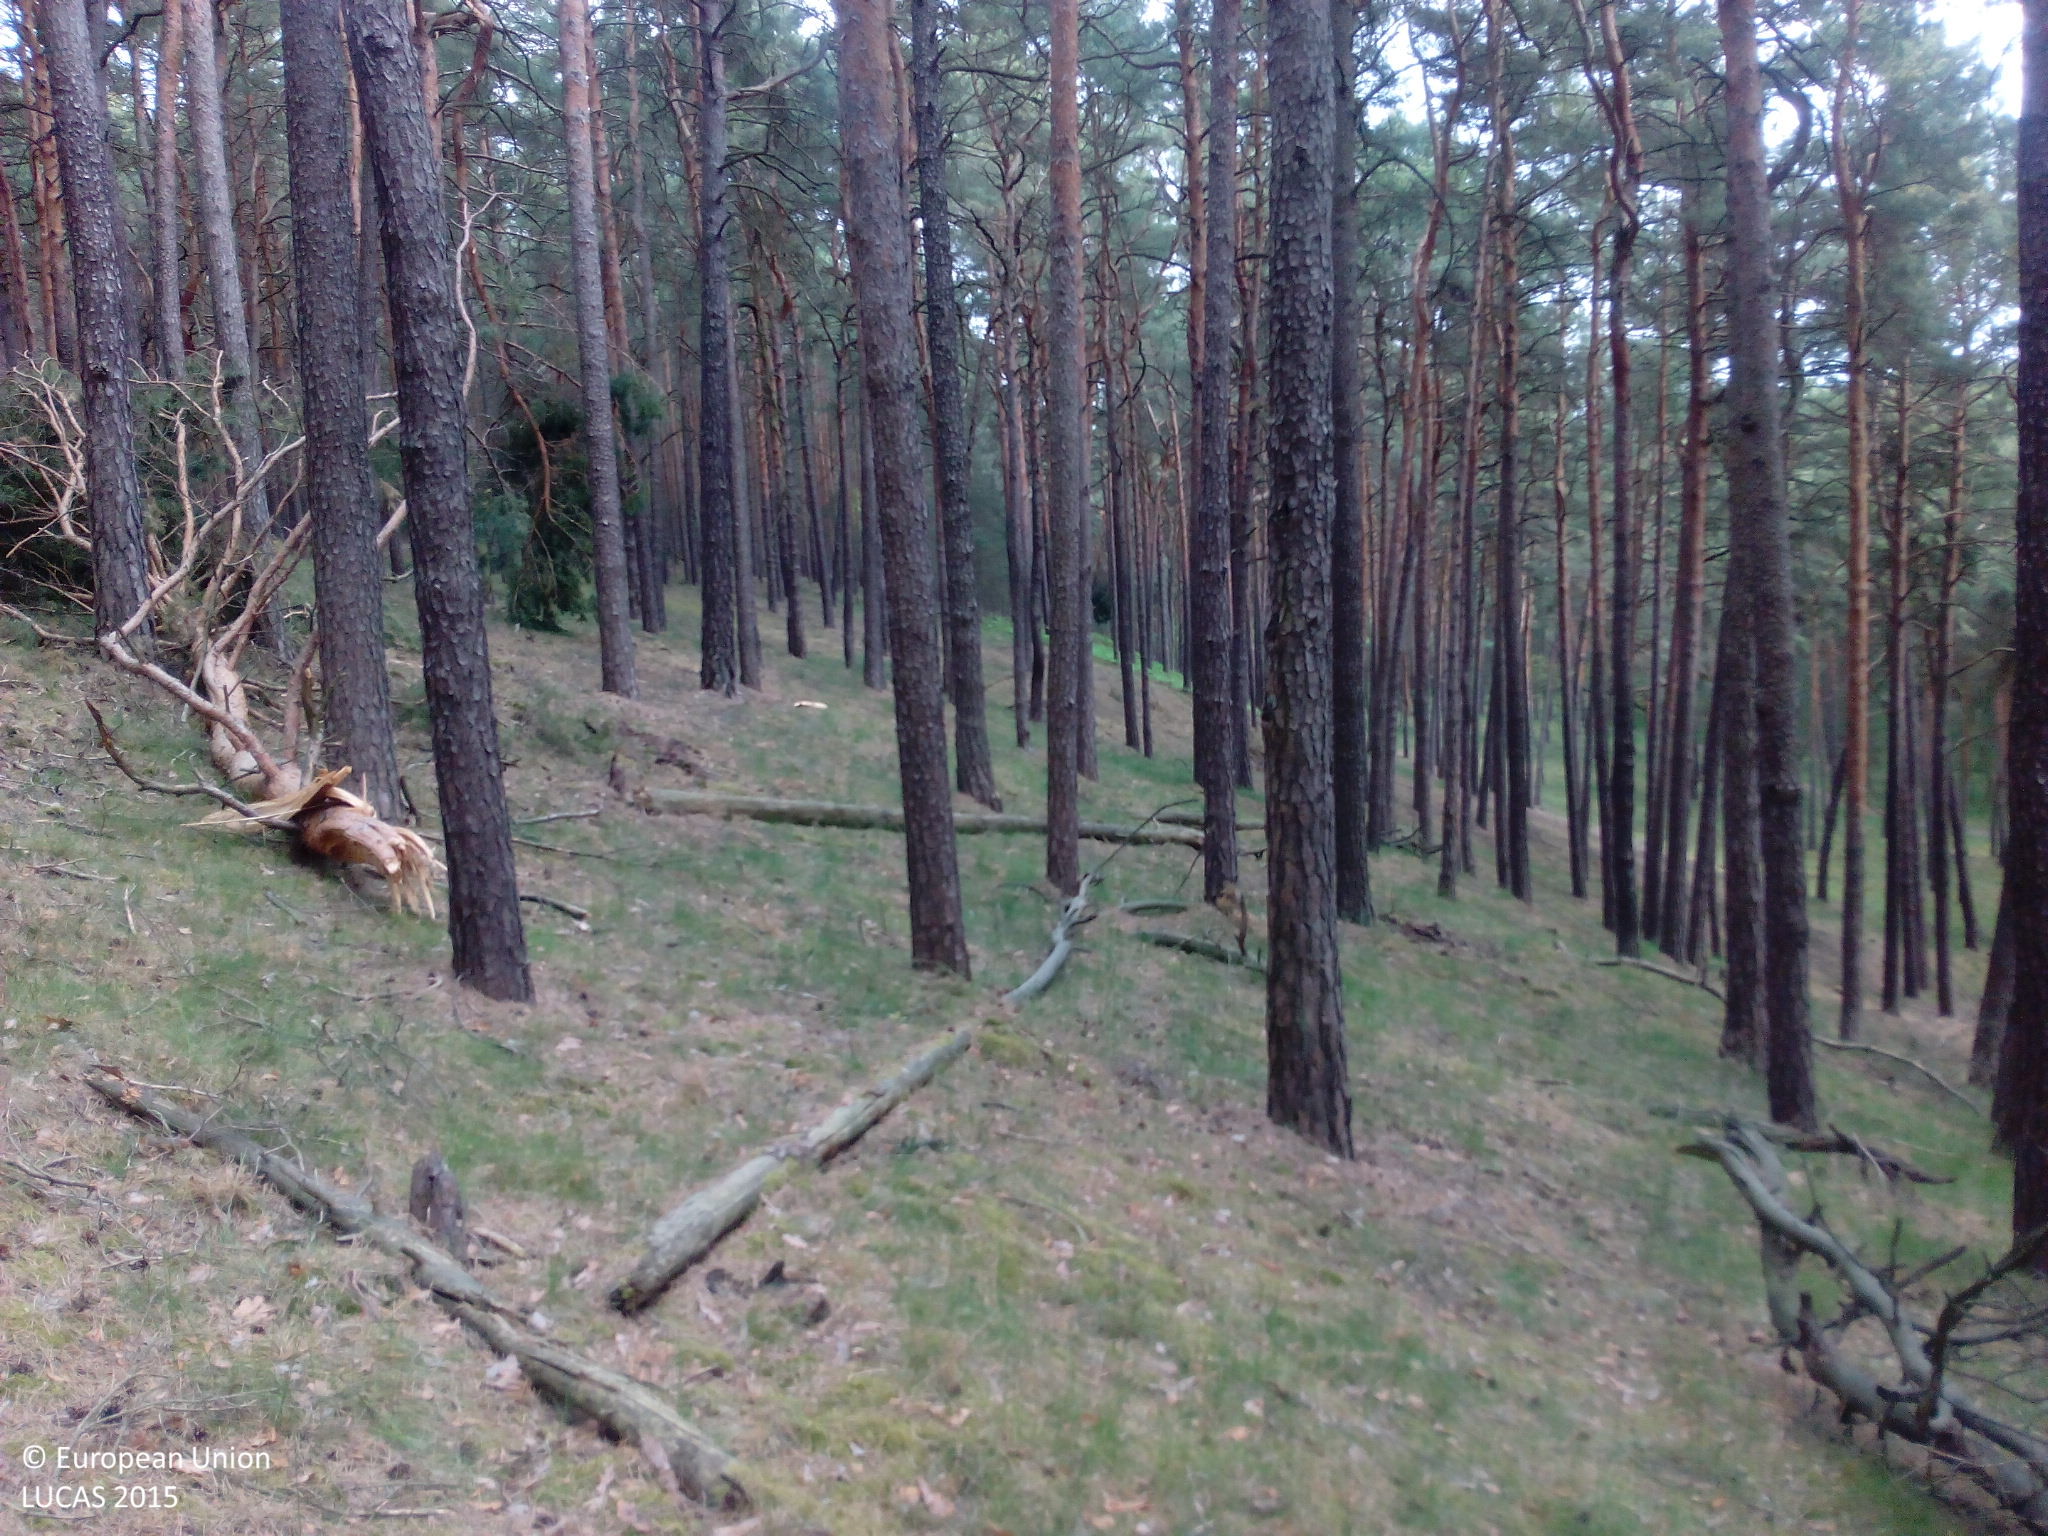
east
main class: Woodland
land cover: Pine dominated coniferous woodland
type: hemiboreal forest and nemoral coniferous forest and mixed broadleaved-coniferous forest
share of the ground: > 75 %
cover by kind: coniferous forest trees 70 %, lichens and mosses 20 %, herbaceous plants 10 %
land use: Forestry
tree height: > 5 m
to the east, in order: Pine dominated coniferous woodland
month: May
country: DE
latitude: 52.2833
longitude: 13.0929
